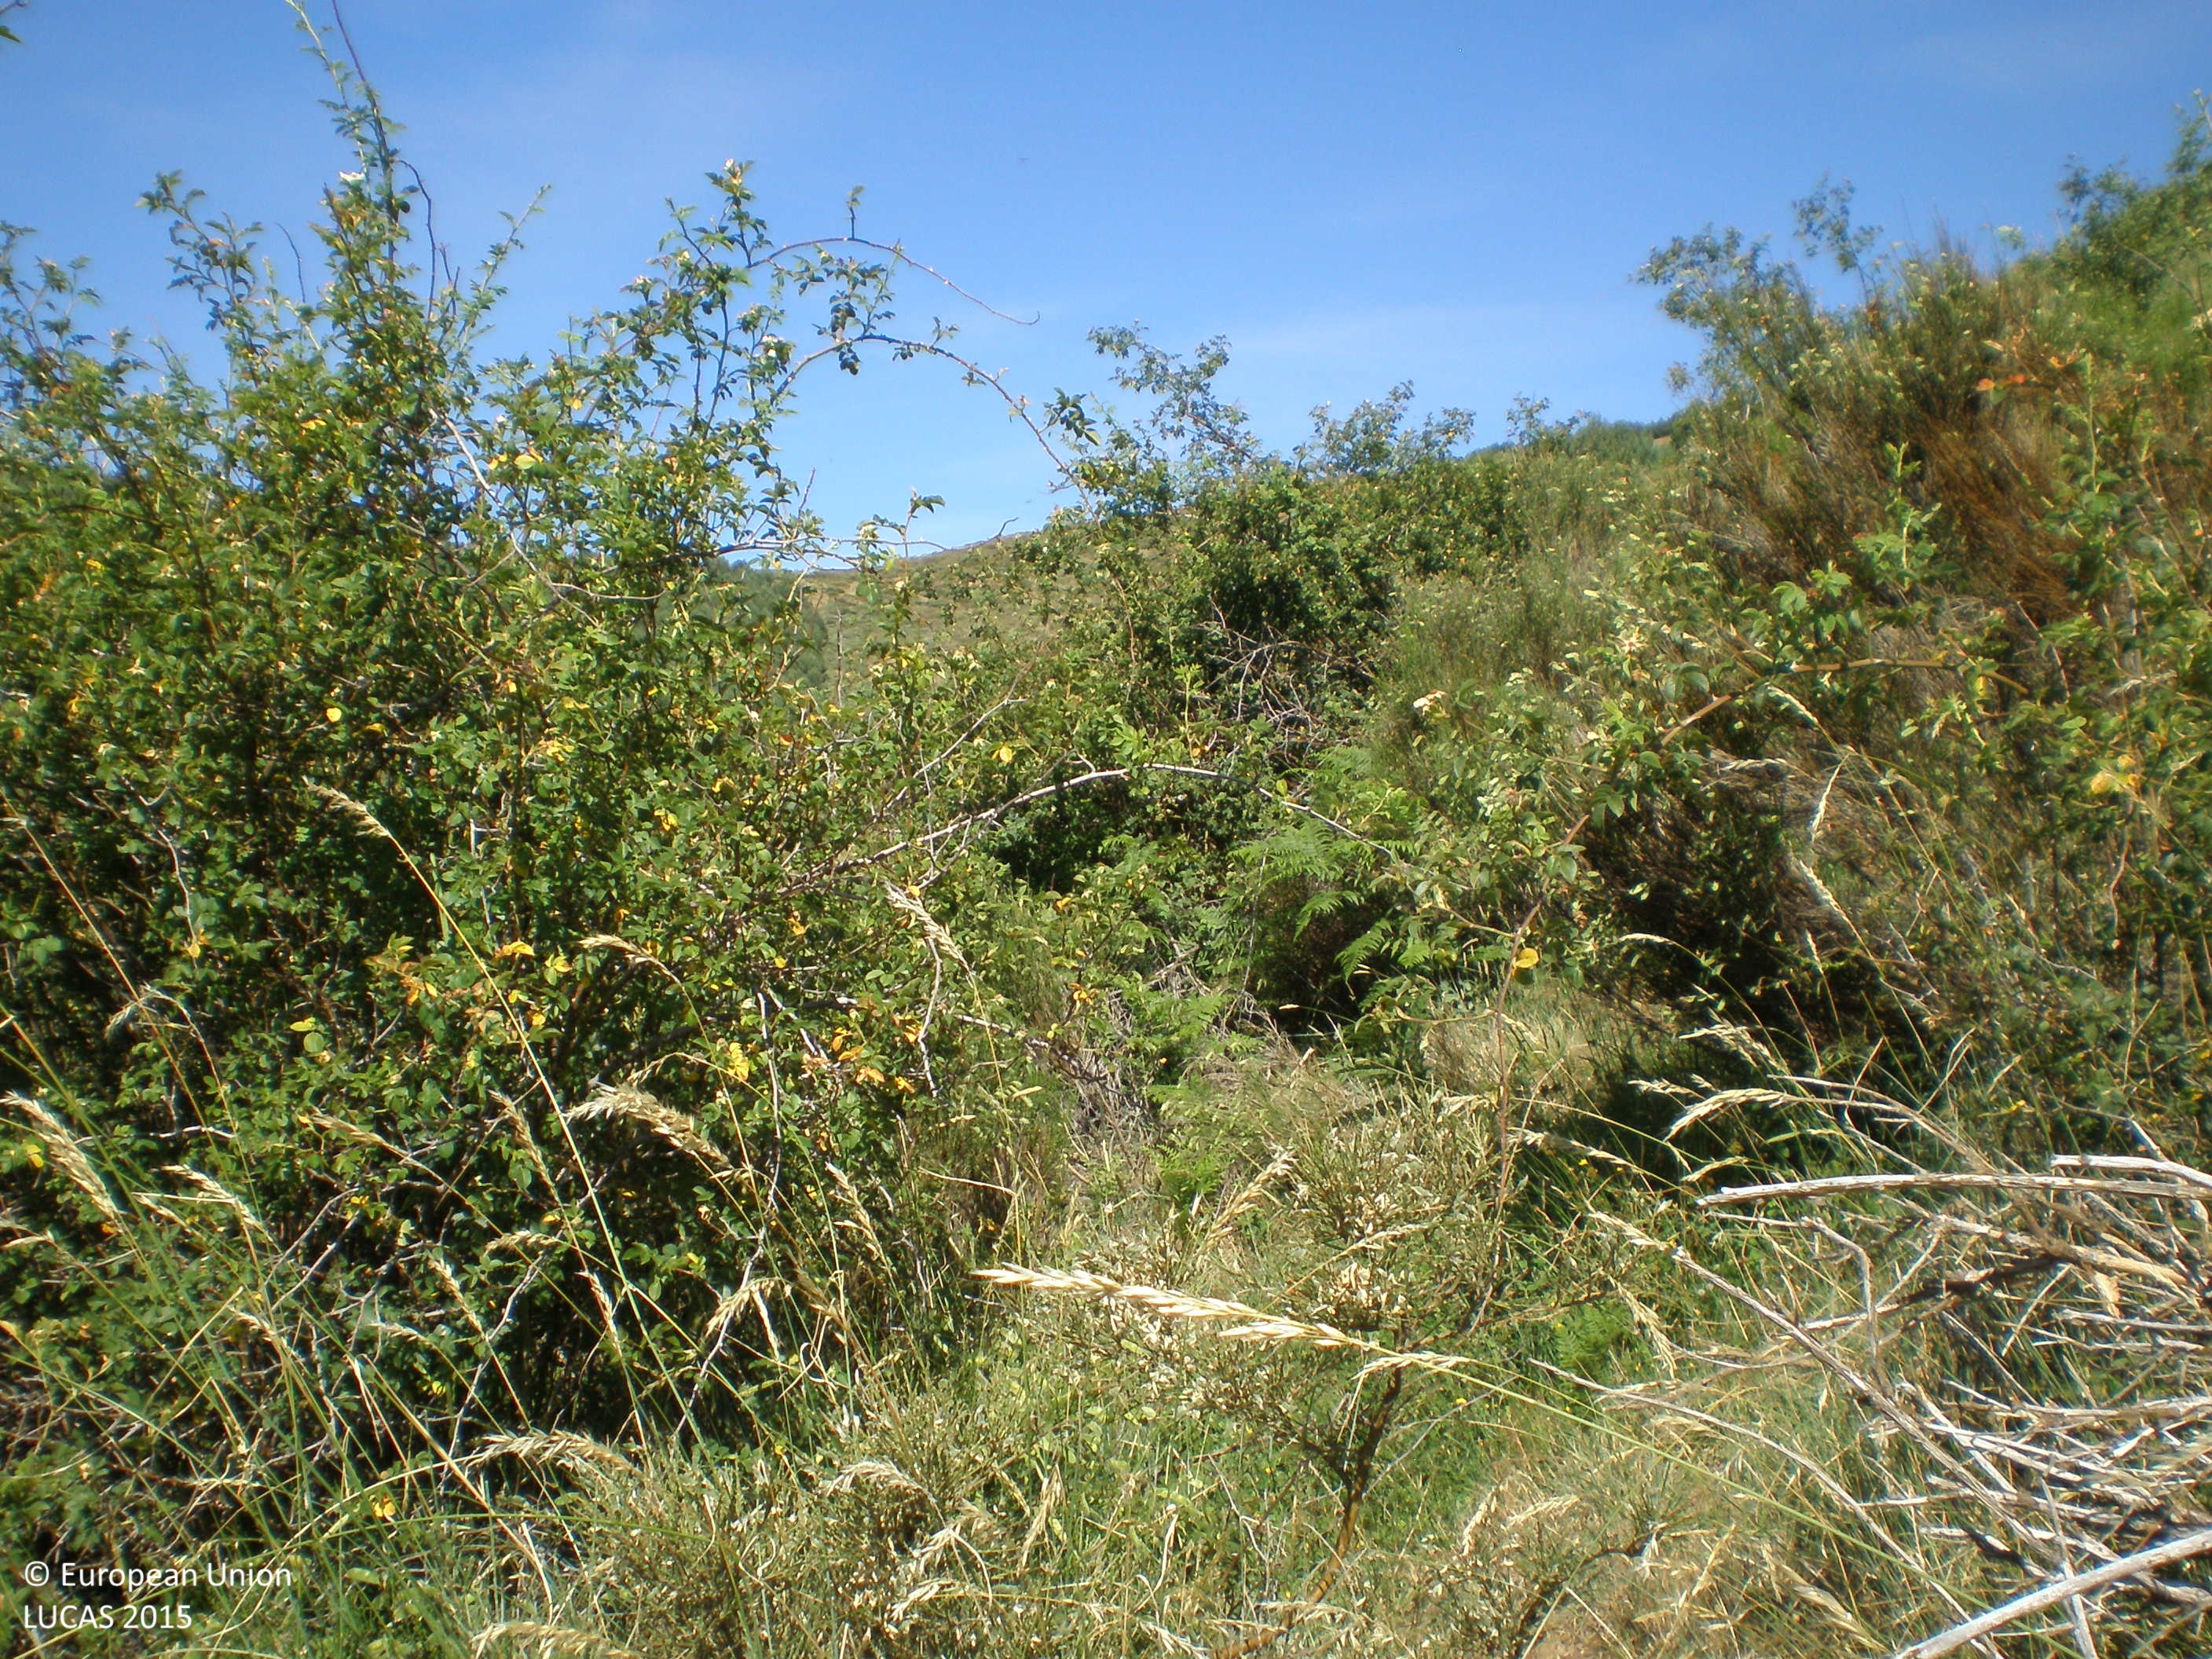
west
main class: Shrubland
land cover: Shrubland without tree cover
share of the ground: > 75 %
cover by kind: shrubs 80 %, herbaceous plants 20 %
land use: Abandoned areas
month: July
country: ES
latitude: 40.4368
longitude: -5.1856
